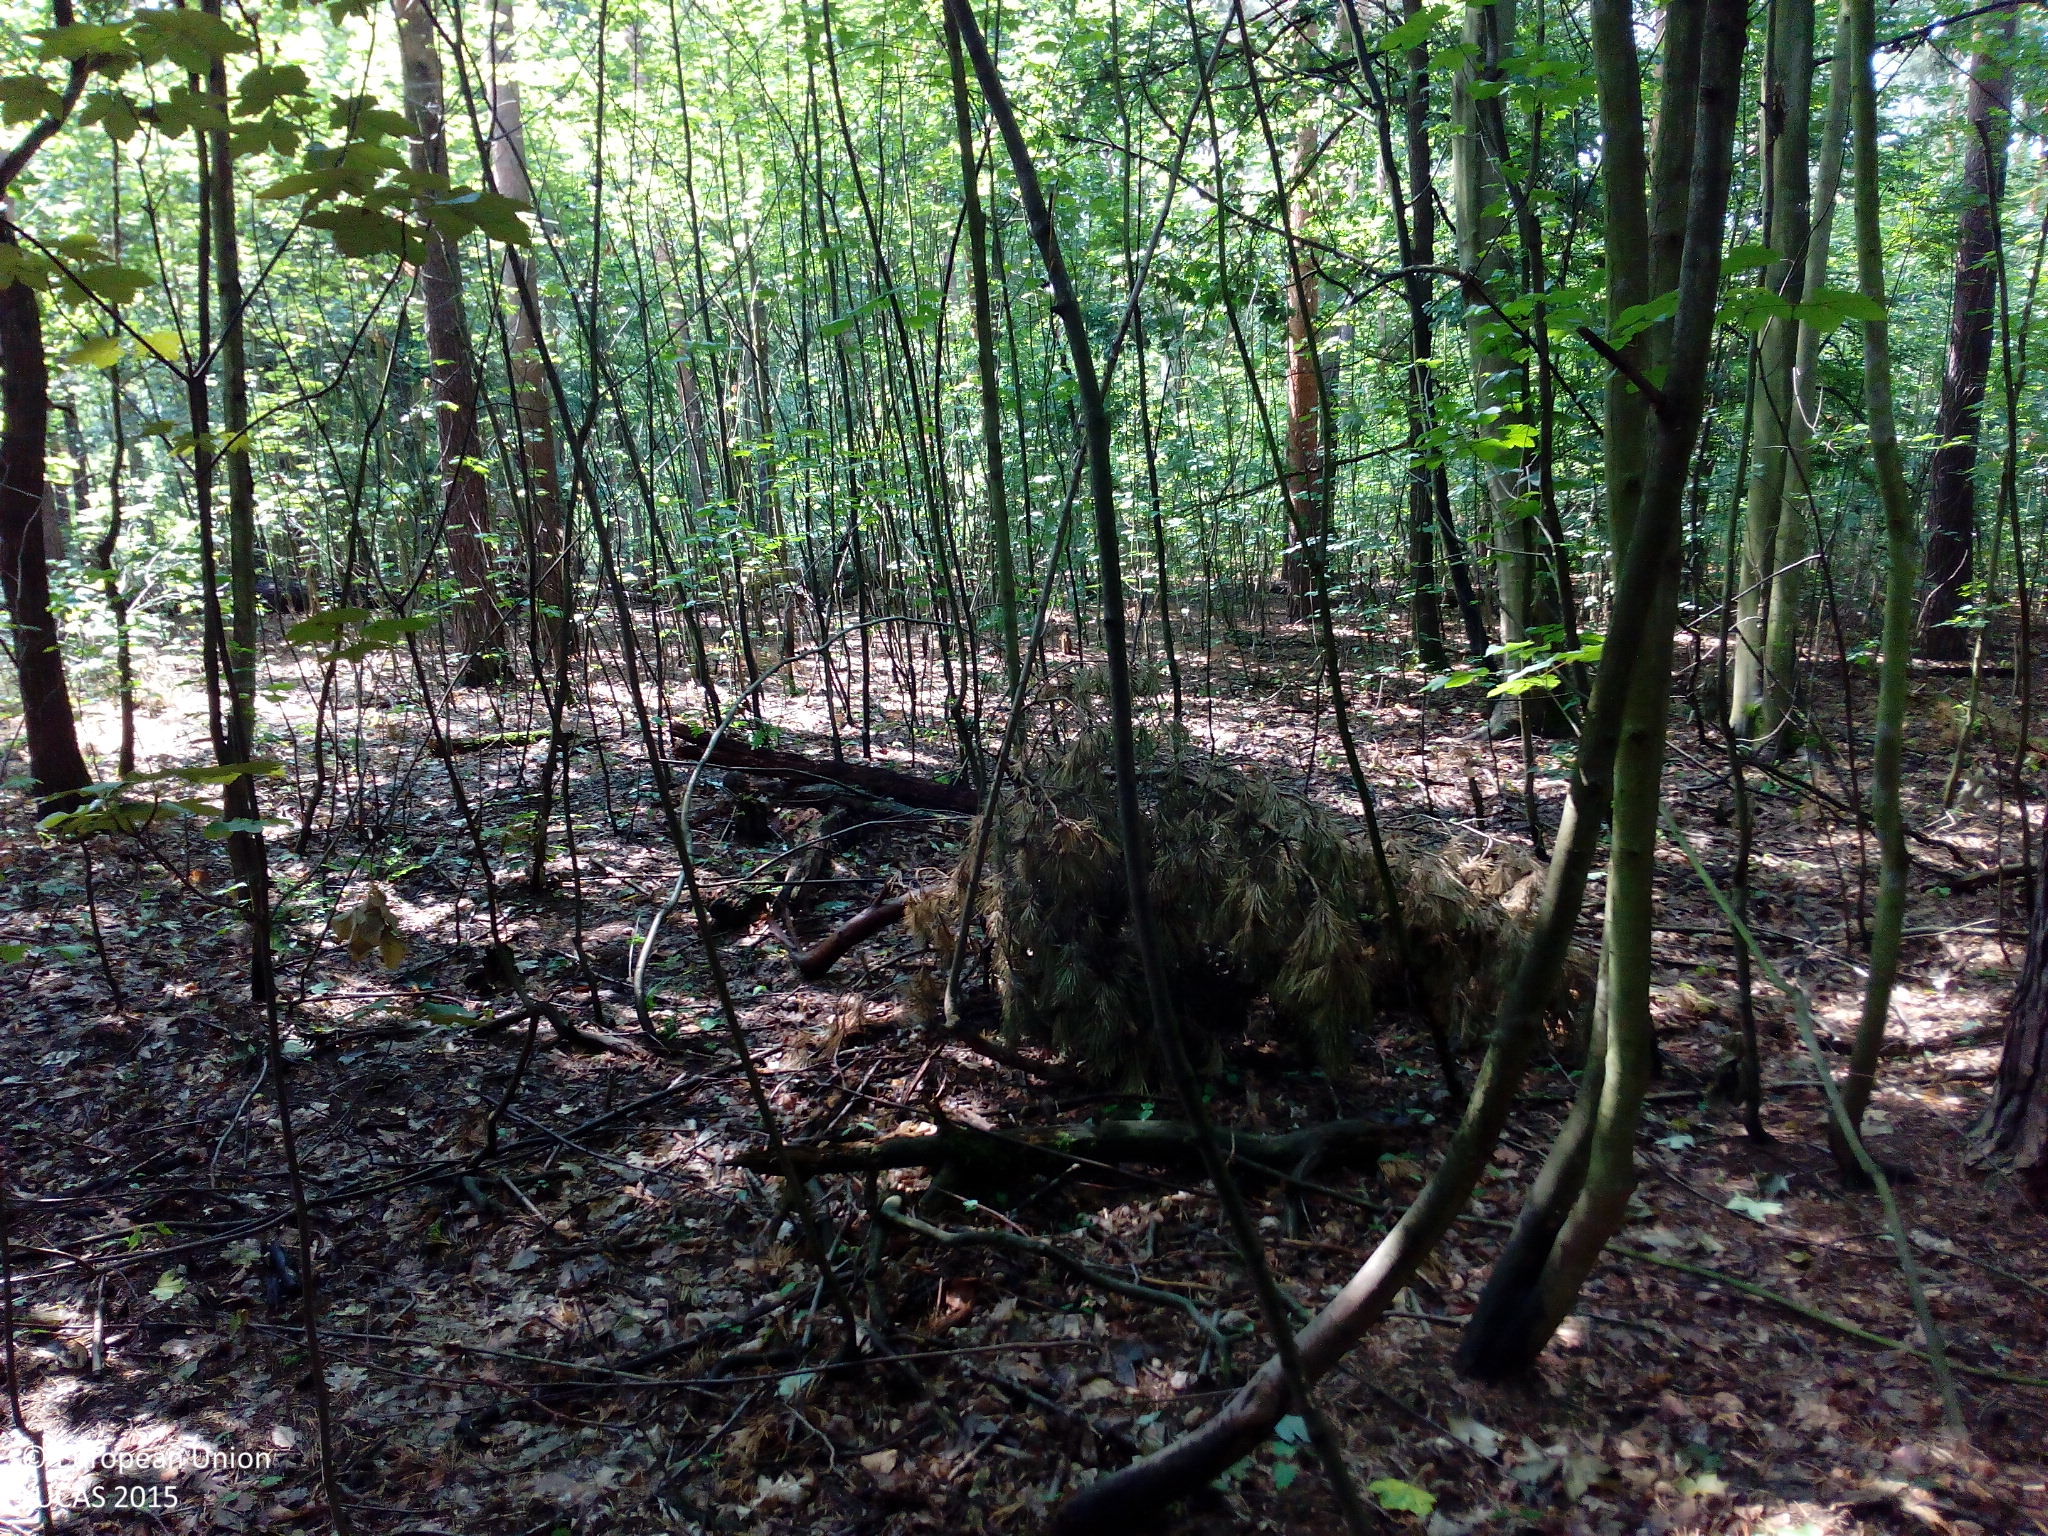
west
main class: Woodland
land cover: Pine dominated mixed woodland
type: hemiboreal forest and nemoral coniferous forest and mixed broadleaved-coniferous forest
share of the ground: > 75 %
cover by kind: coniferous forest trees 70 %, broadleaved forest trees 30 %
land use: Forestry
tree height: > 5 m
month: July
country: DE
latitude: 52.4605
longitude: 13.1937
